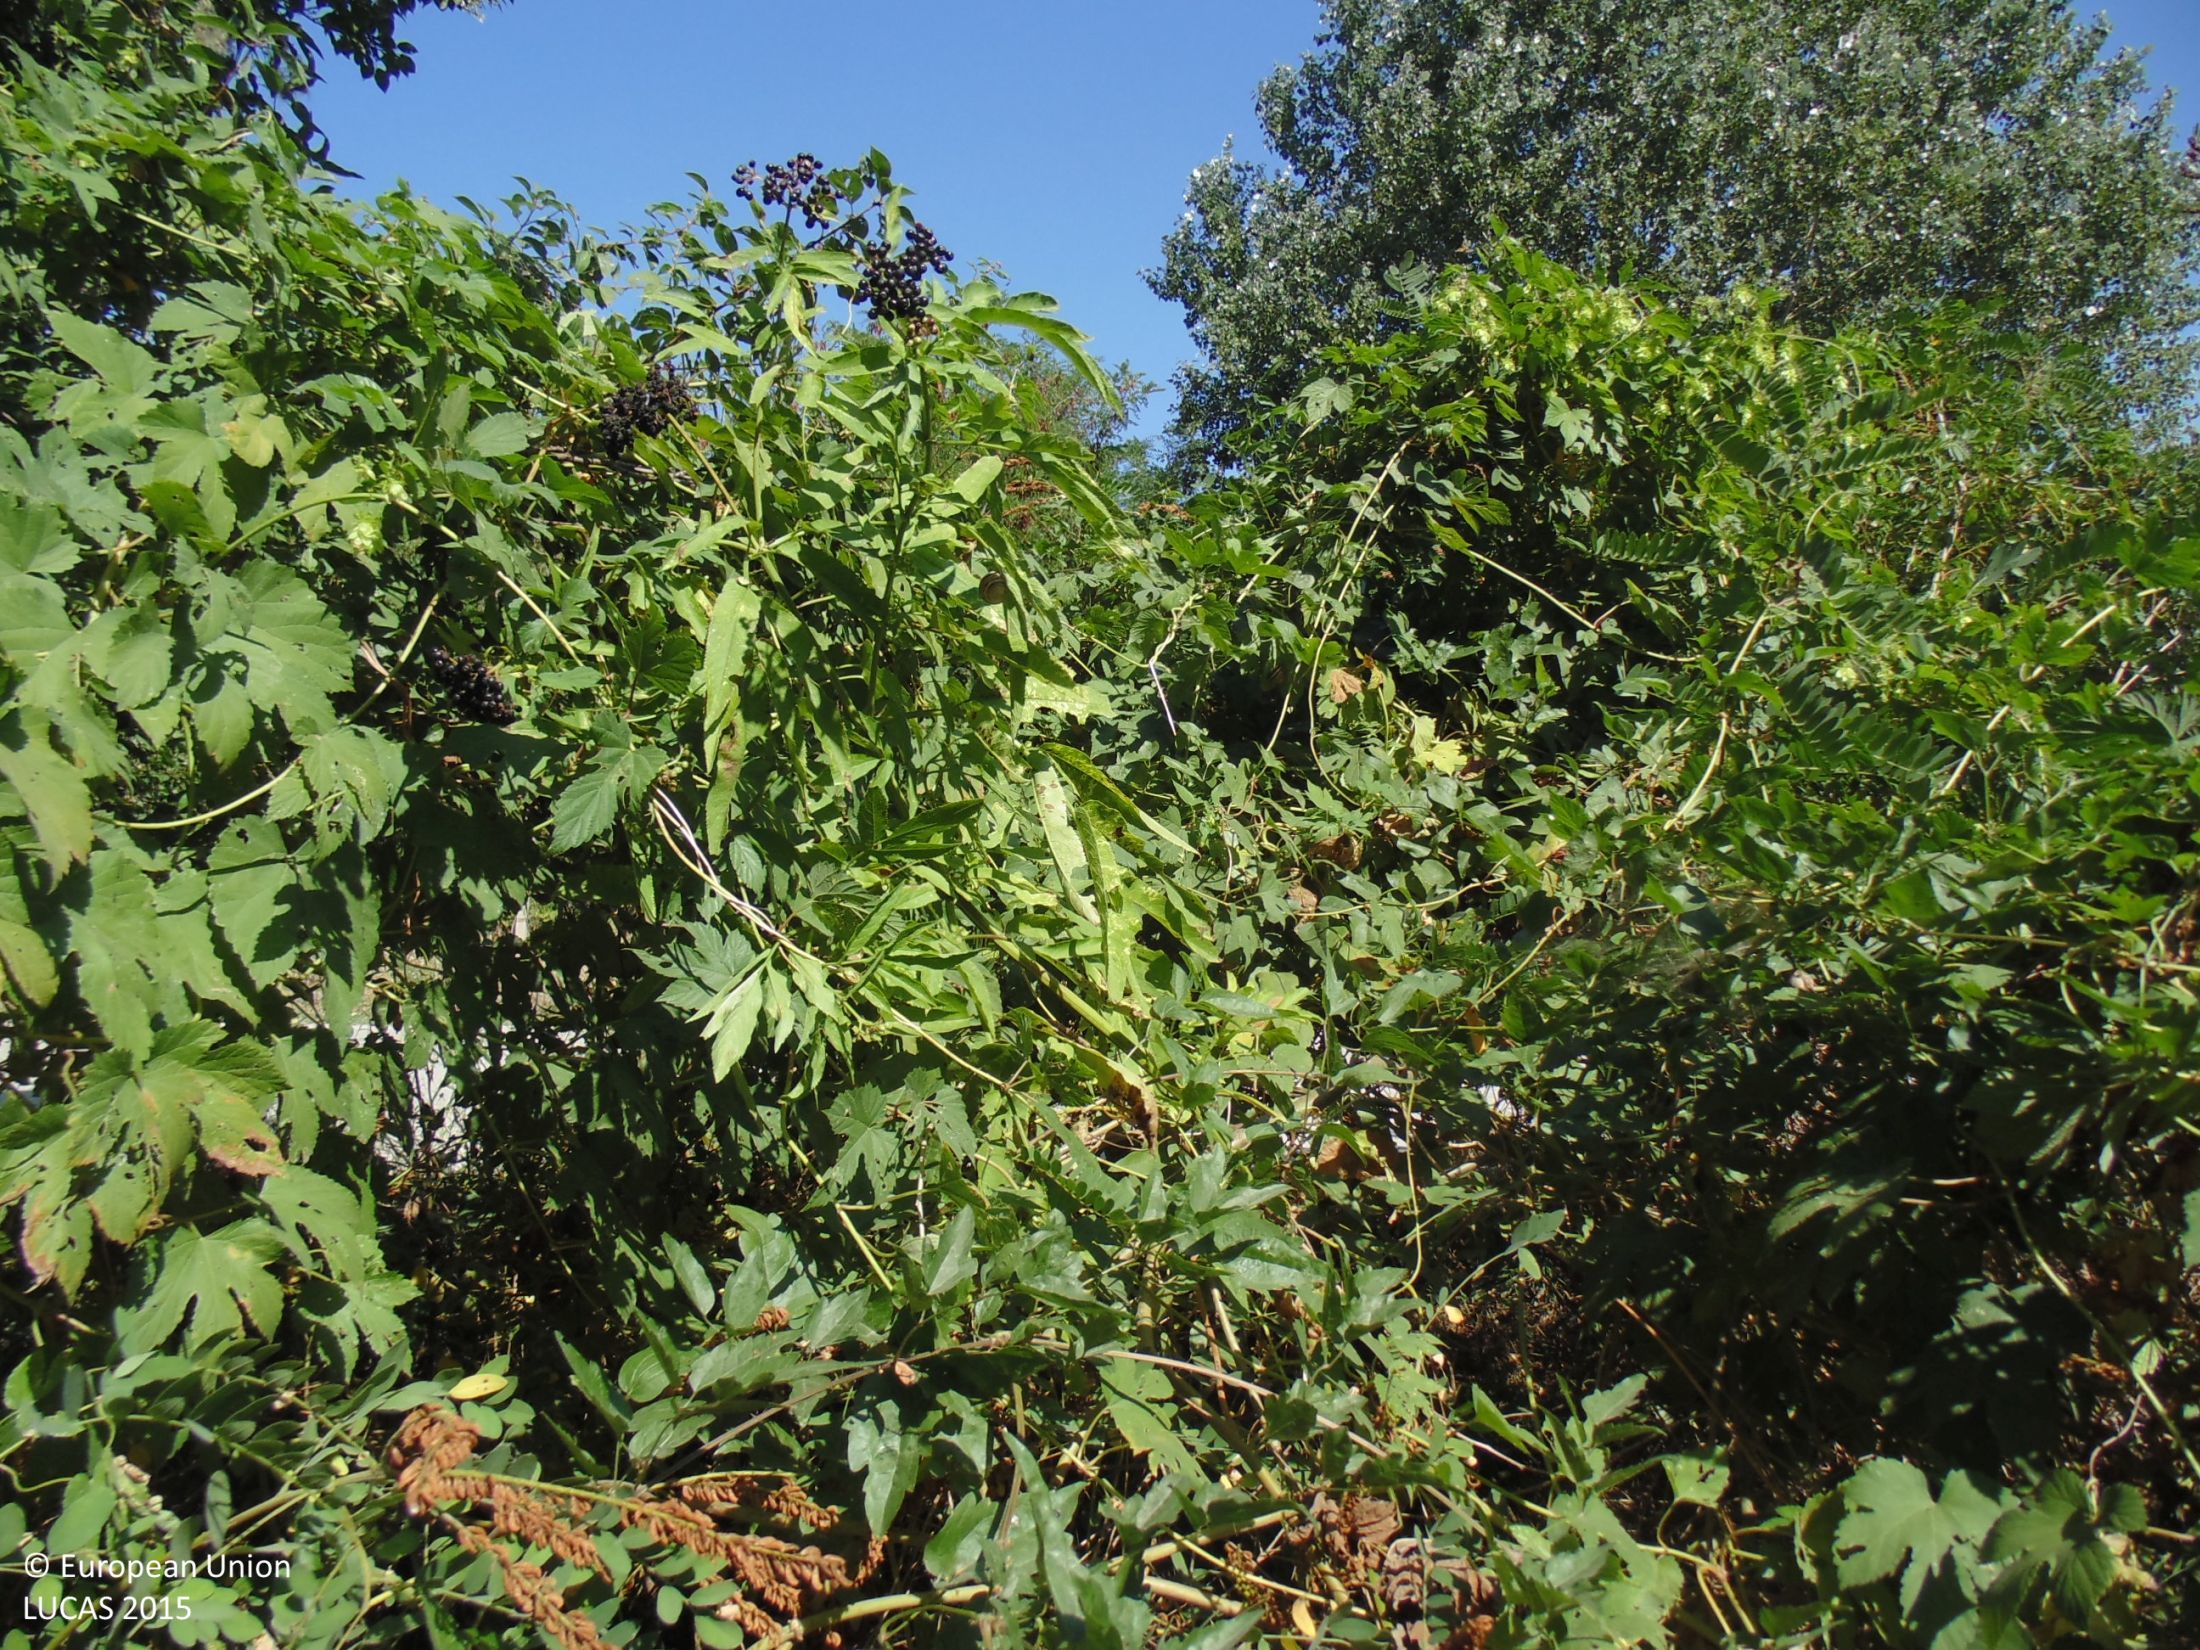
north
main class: Grassland
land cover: Grassland with sparse tree/shrub cover
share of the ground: > 75 %
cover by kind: herbaceous plants 90 %, broadleaved forest trees 5 %, shrubs 5 %
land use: Abandoned areas
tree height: > 5 m
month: September
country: BG
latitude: 44.1102
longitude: 27.2353
